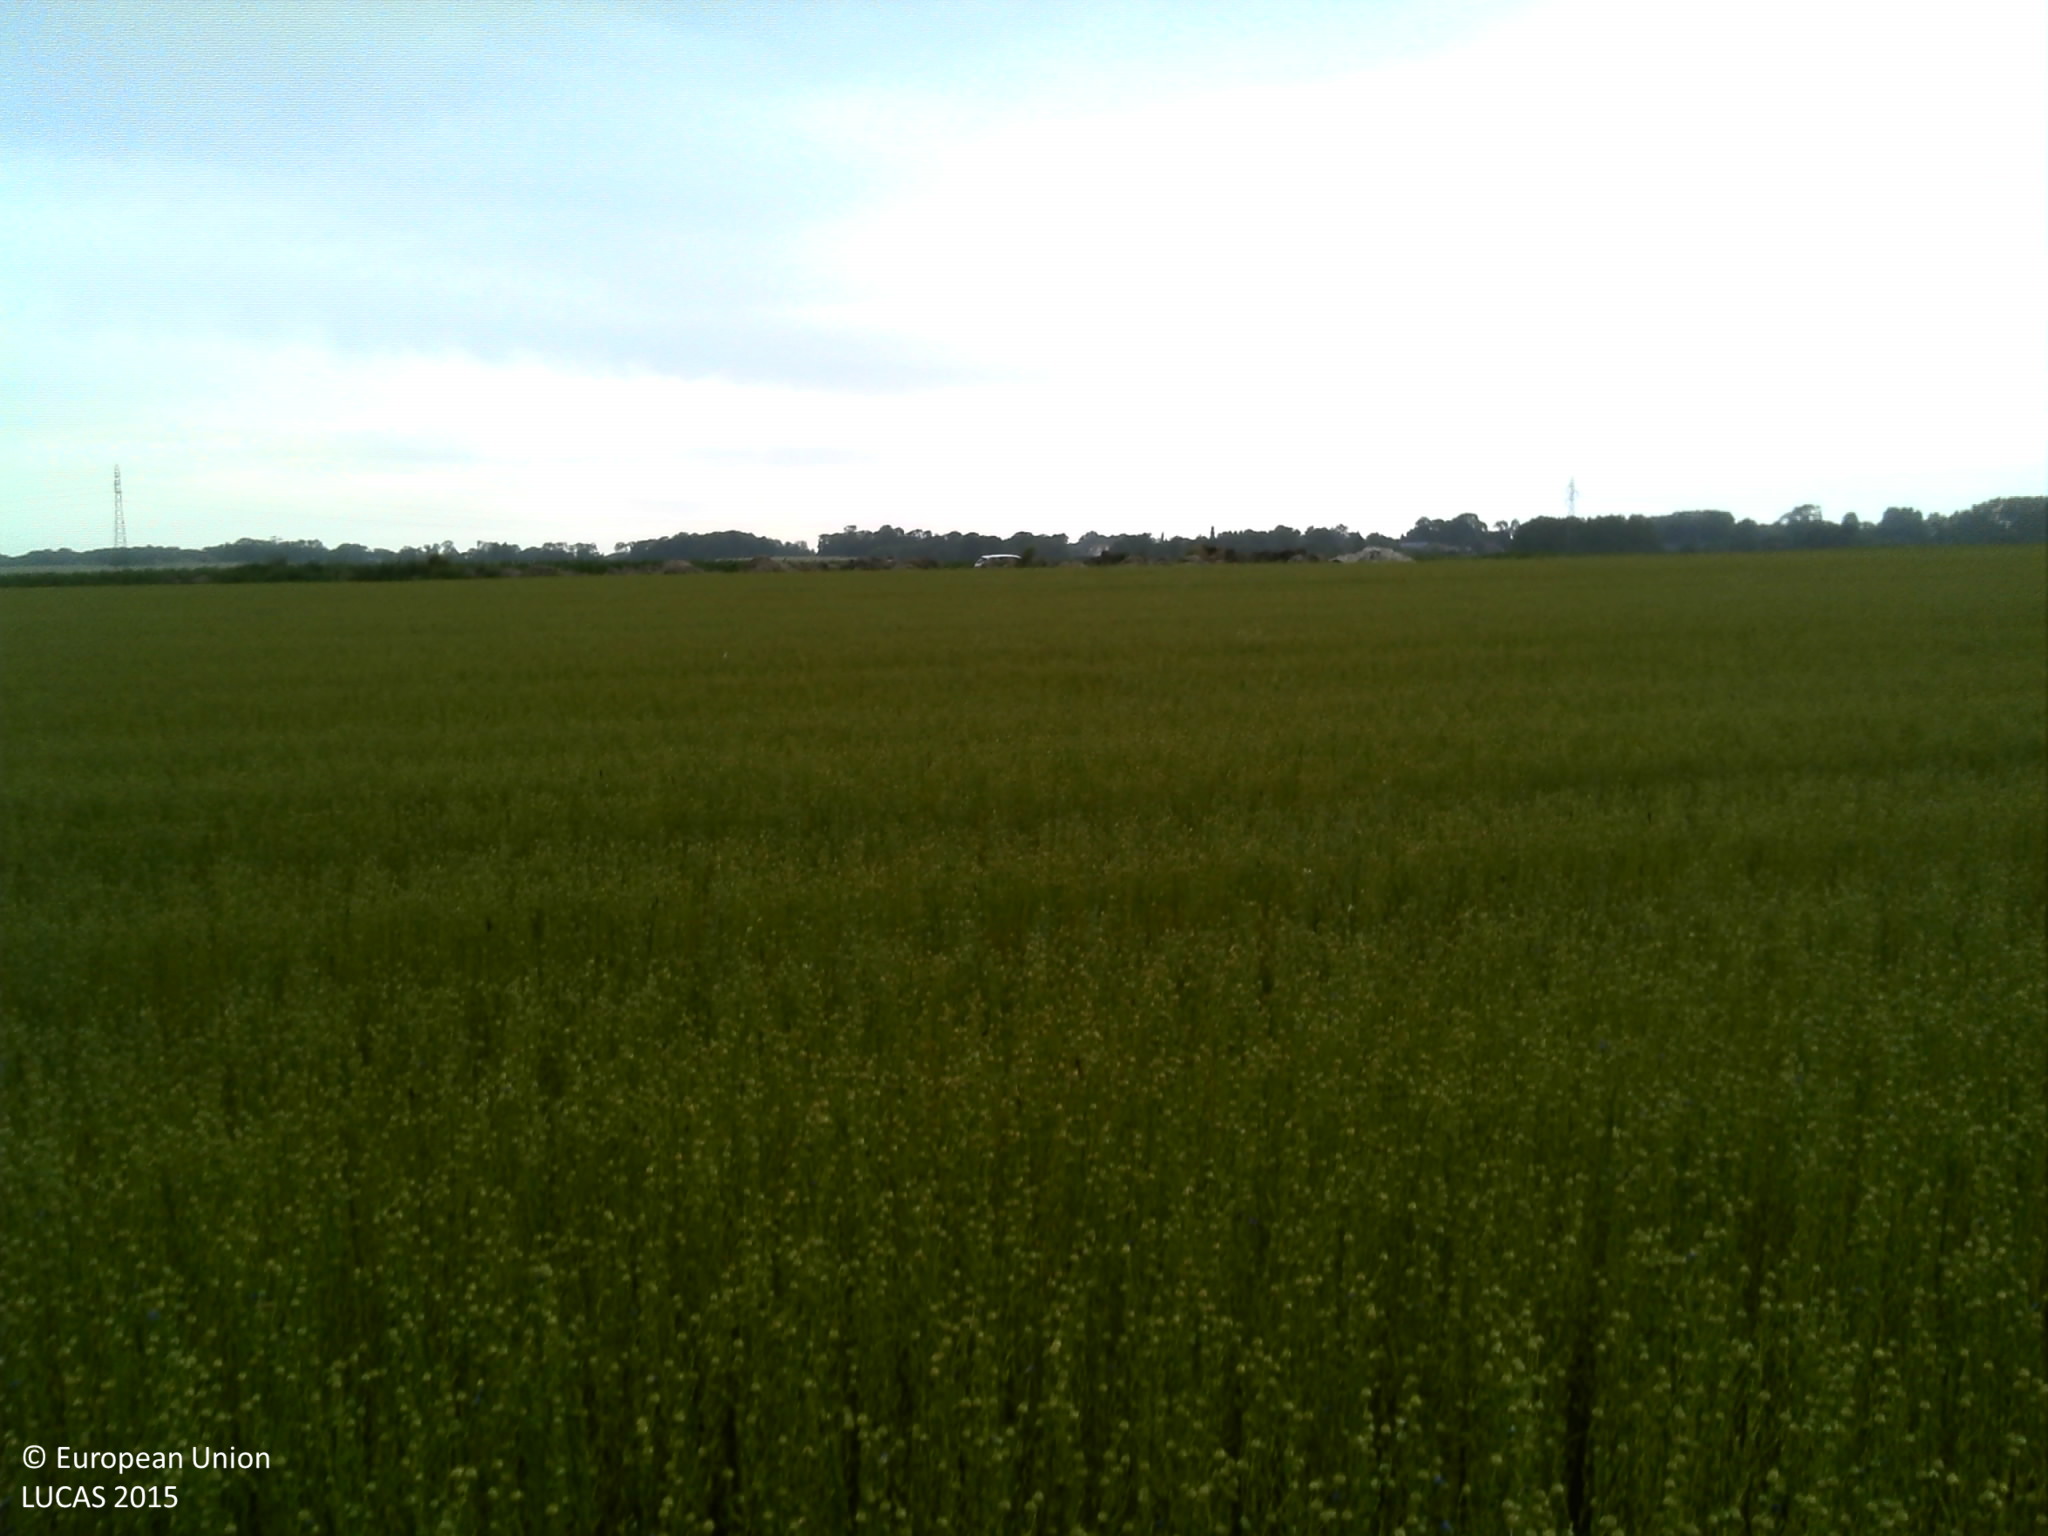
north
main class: Cropland
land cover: Other fibre and oleaginous crops
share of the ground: > 75 %
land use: Agriculture (excluding fallow land and kitchen gardens)
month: July
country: FR
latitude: 49.8843
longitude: 1.0285
